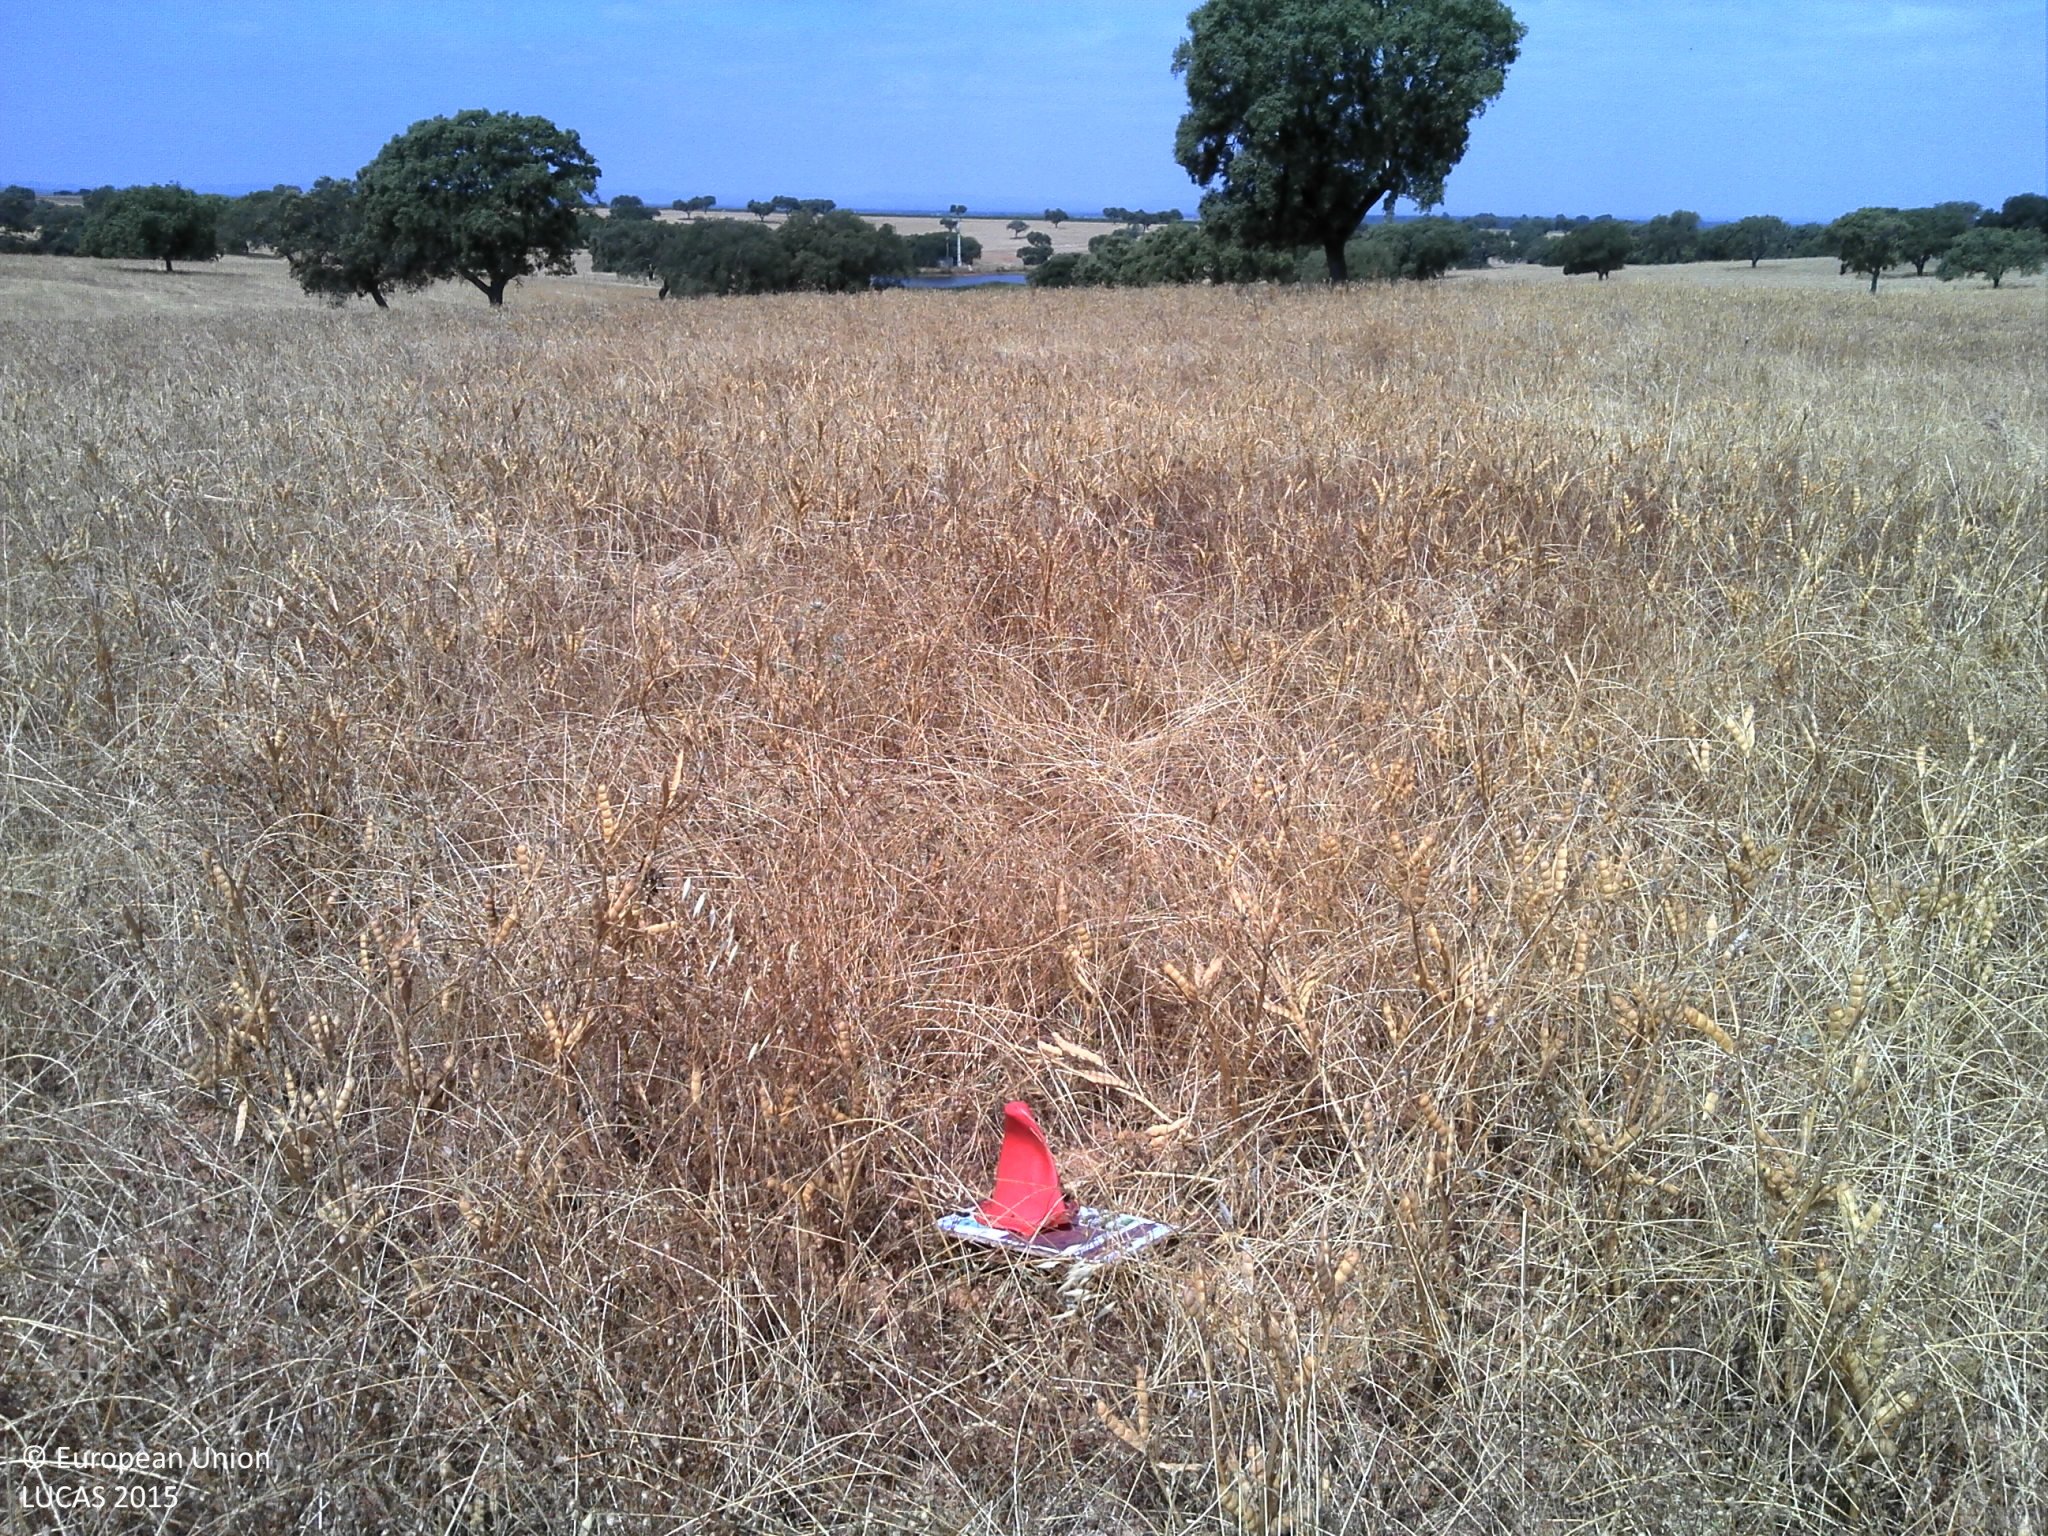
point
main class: Grassland
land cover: Grassland without tree/shrub cover
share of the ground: > 75 %
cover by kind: herbaceous plants 90 %, unconsolidated bare surface 10 %
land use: Agriculture (excluding fallow land and kitchen gardens)
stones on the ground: < 10 %
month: June
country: PT
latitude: 37.8410
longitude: -8.3189
